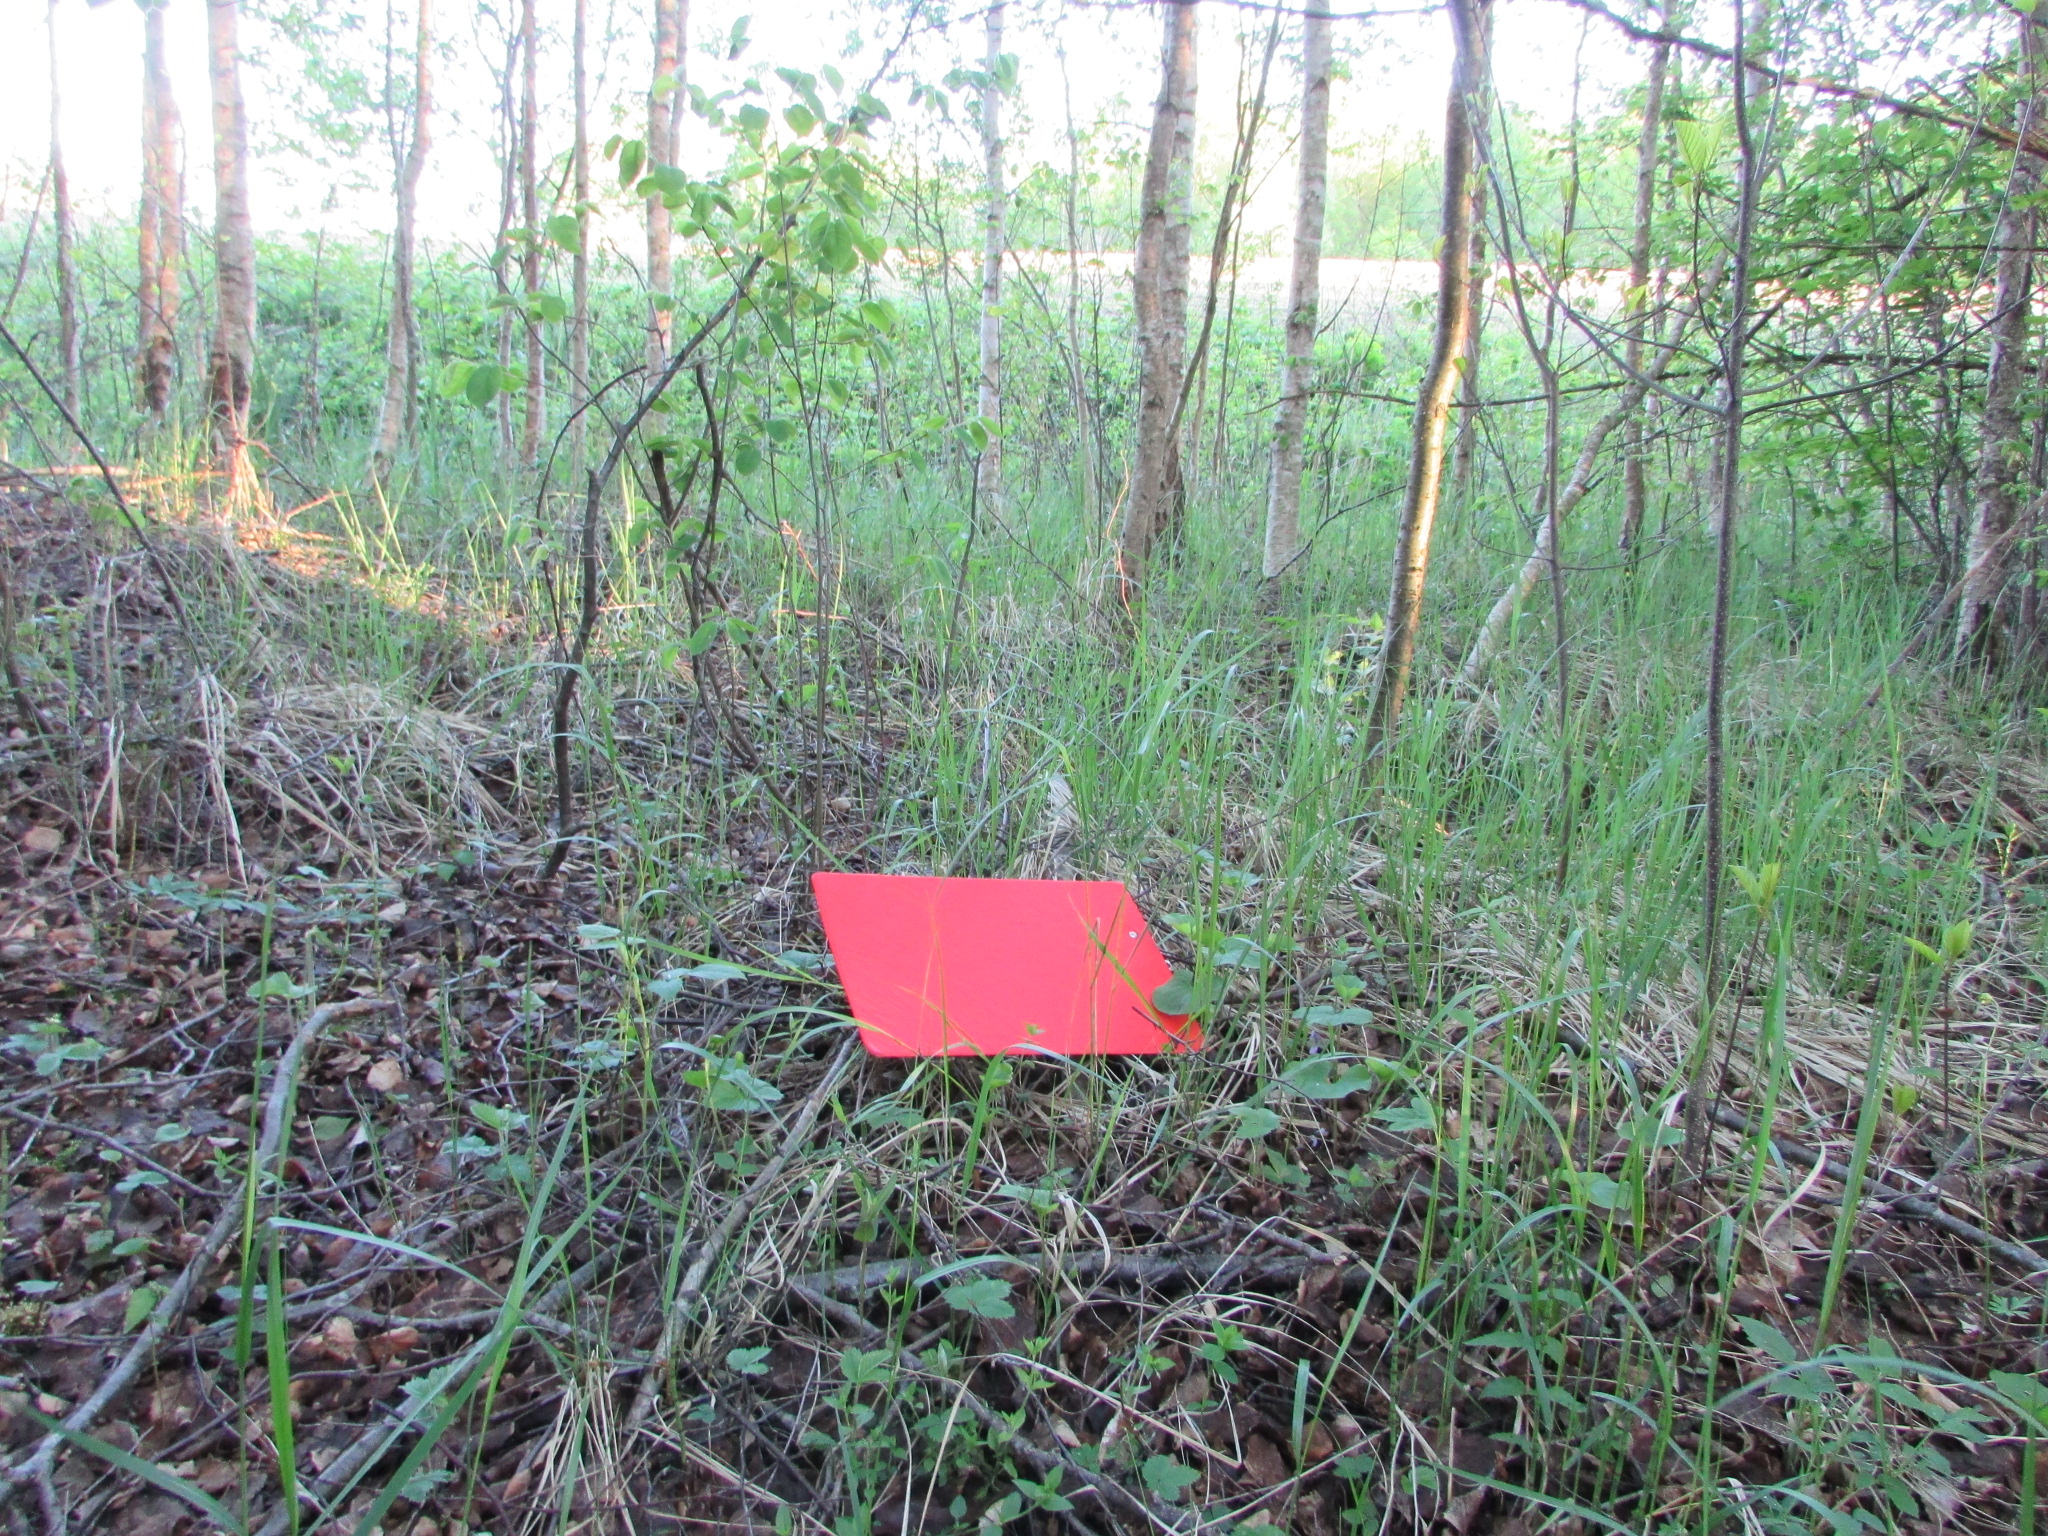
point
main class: Woodland
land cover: Broadleaved woodland
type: non-riverine alder, birch or aspen forest
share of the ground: > 75 %
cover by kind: broadleaved forest trees 100 %
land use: Forestry
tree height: > 5 m
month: May
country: LV
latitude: 56.1966
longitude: 27.1732
